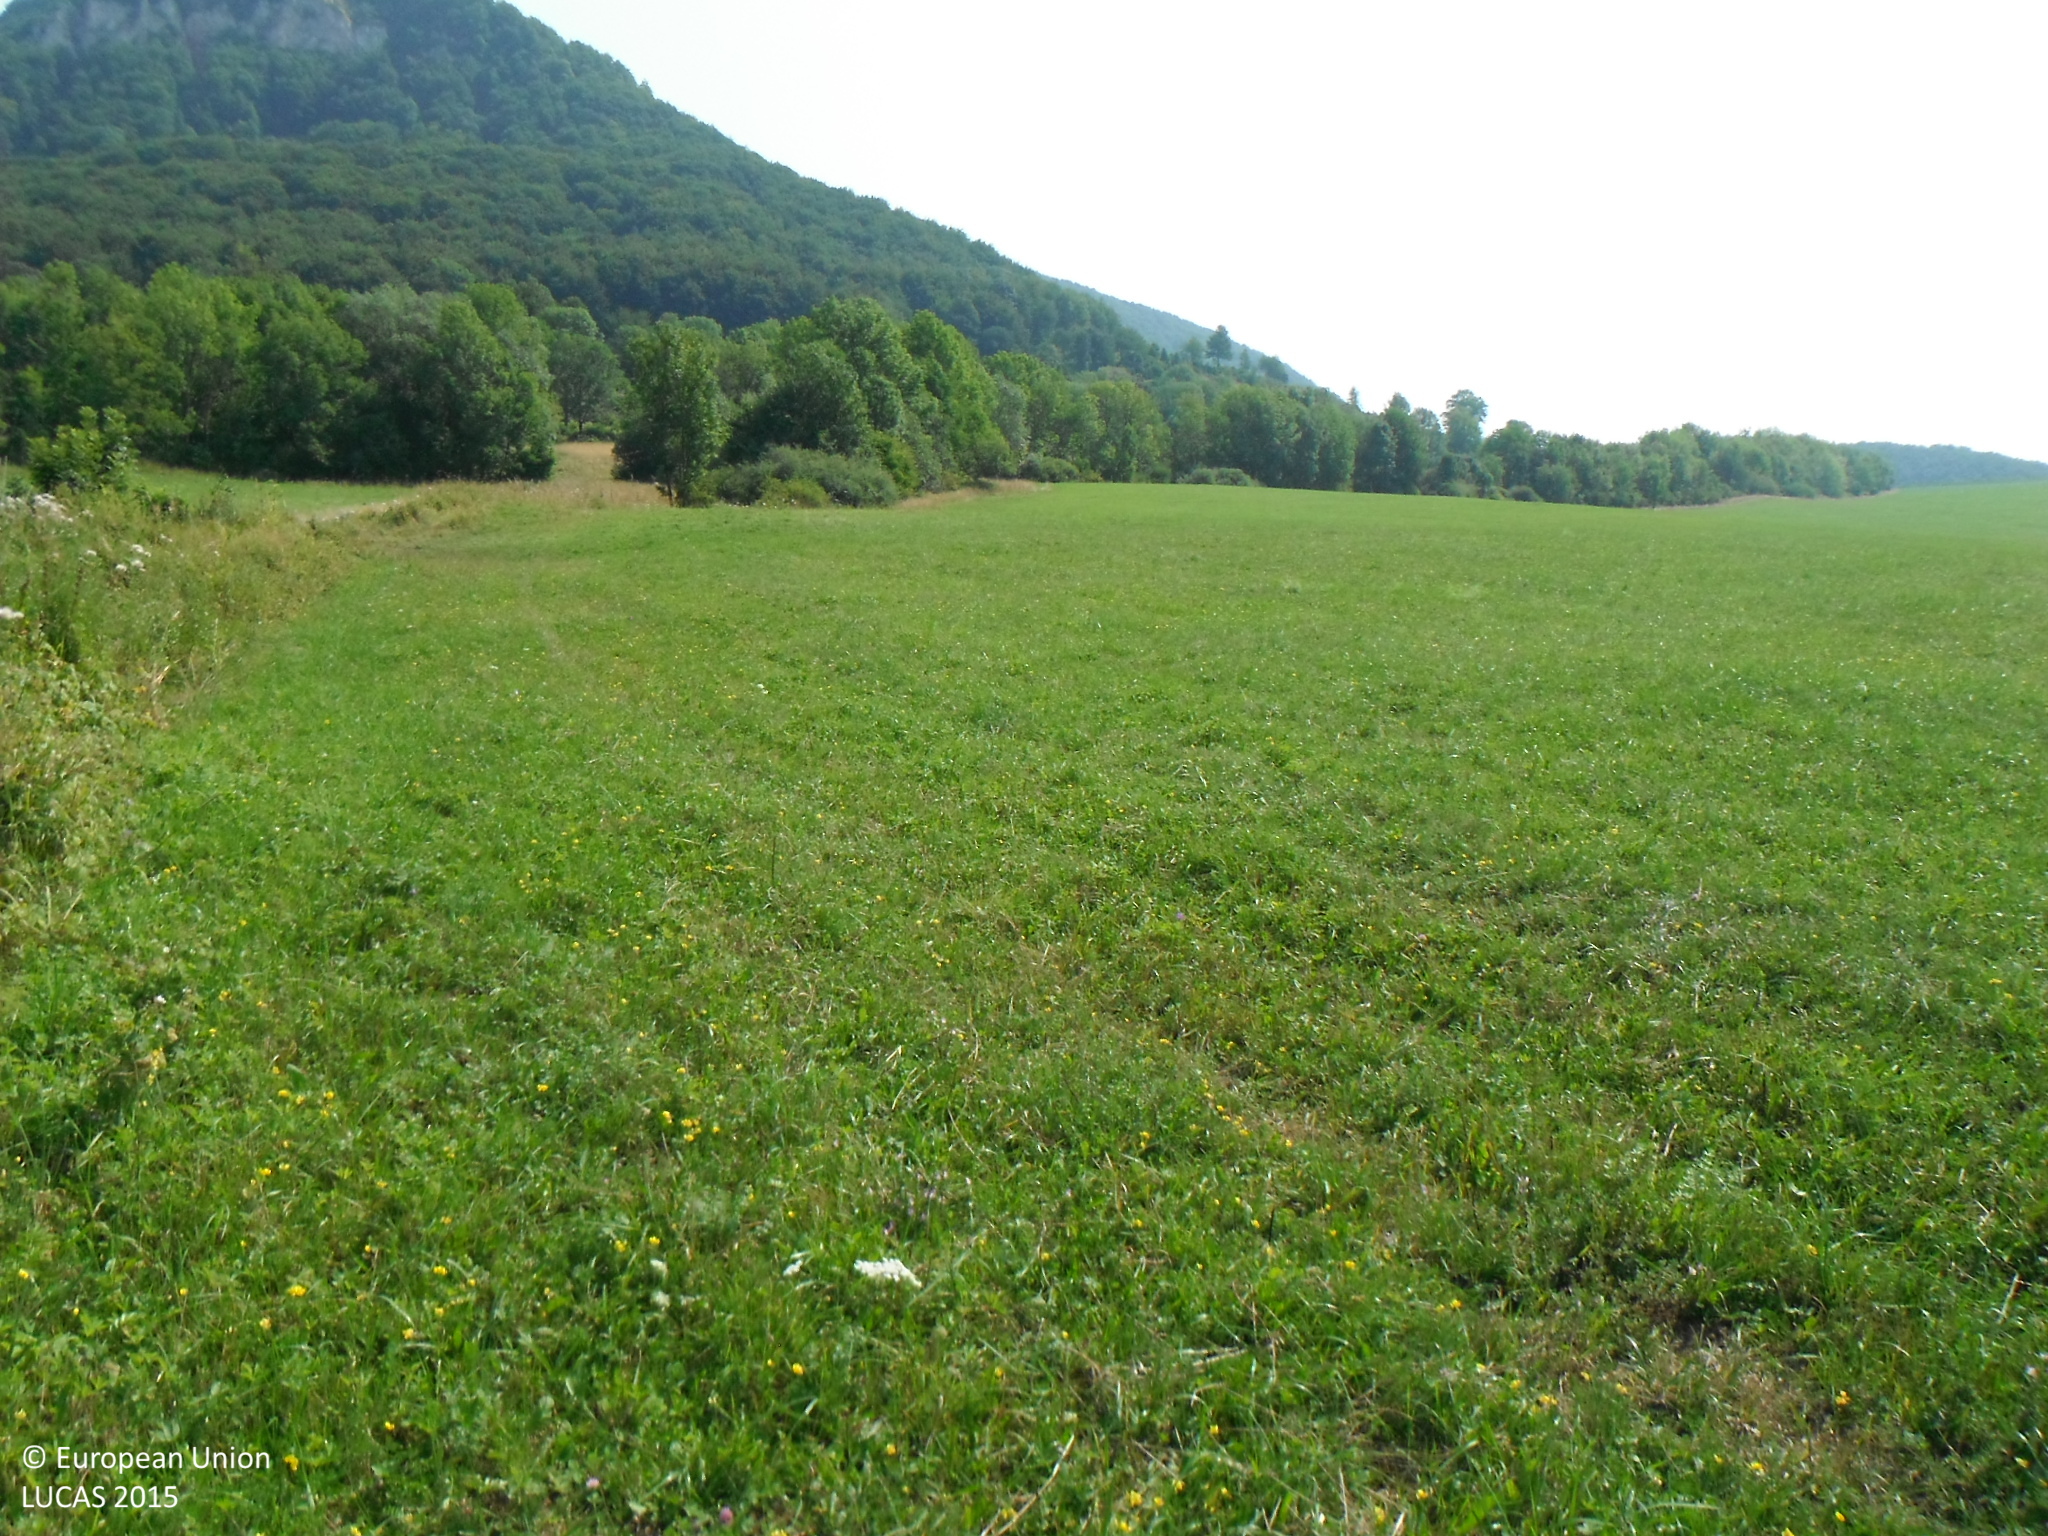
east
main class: Grassland
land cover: Grassland without tree/shrub cover
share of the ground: > 75 %
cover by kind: herbaceous plants 100 %
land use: Agriculture (excluding fallow land and kitchen gardens)
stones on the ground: 10 - 25 %
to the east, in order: Grassland without tree/shrub cover; Broadleaved woodland; Tracks; Ditches and canals; Broadleaved woodland; Grassland without tree/shrub cover
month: August
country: SK
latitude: 48.9485
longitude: 18.4423
